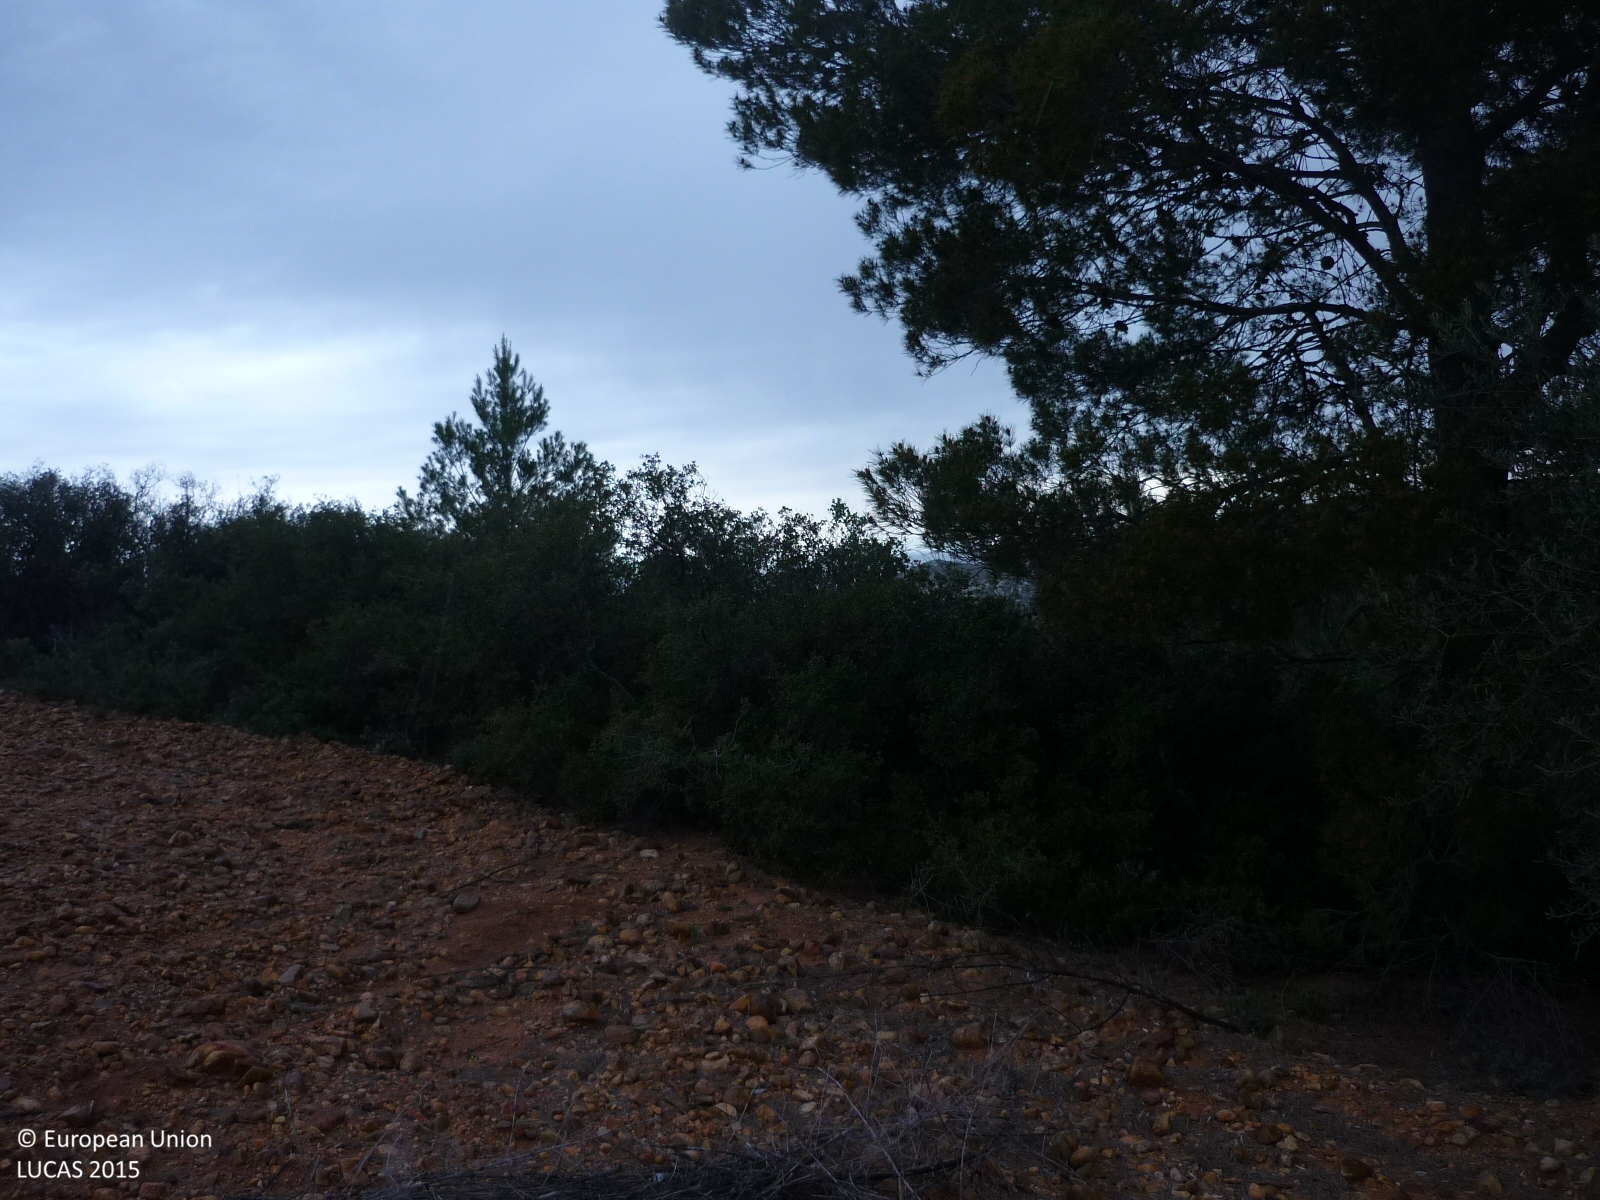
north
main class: Cropland
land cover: Olive groves
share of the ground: 10 - 25 %
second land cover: Other bare soil
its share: > 75 %
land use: Agriculture (excluding fallow land and kitchen gardens)
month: April
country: ES
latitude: 40.3721
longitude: -3.3766
